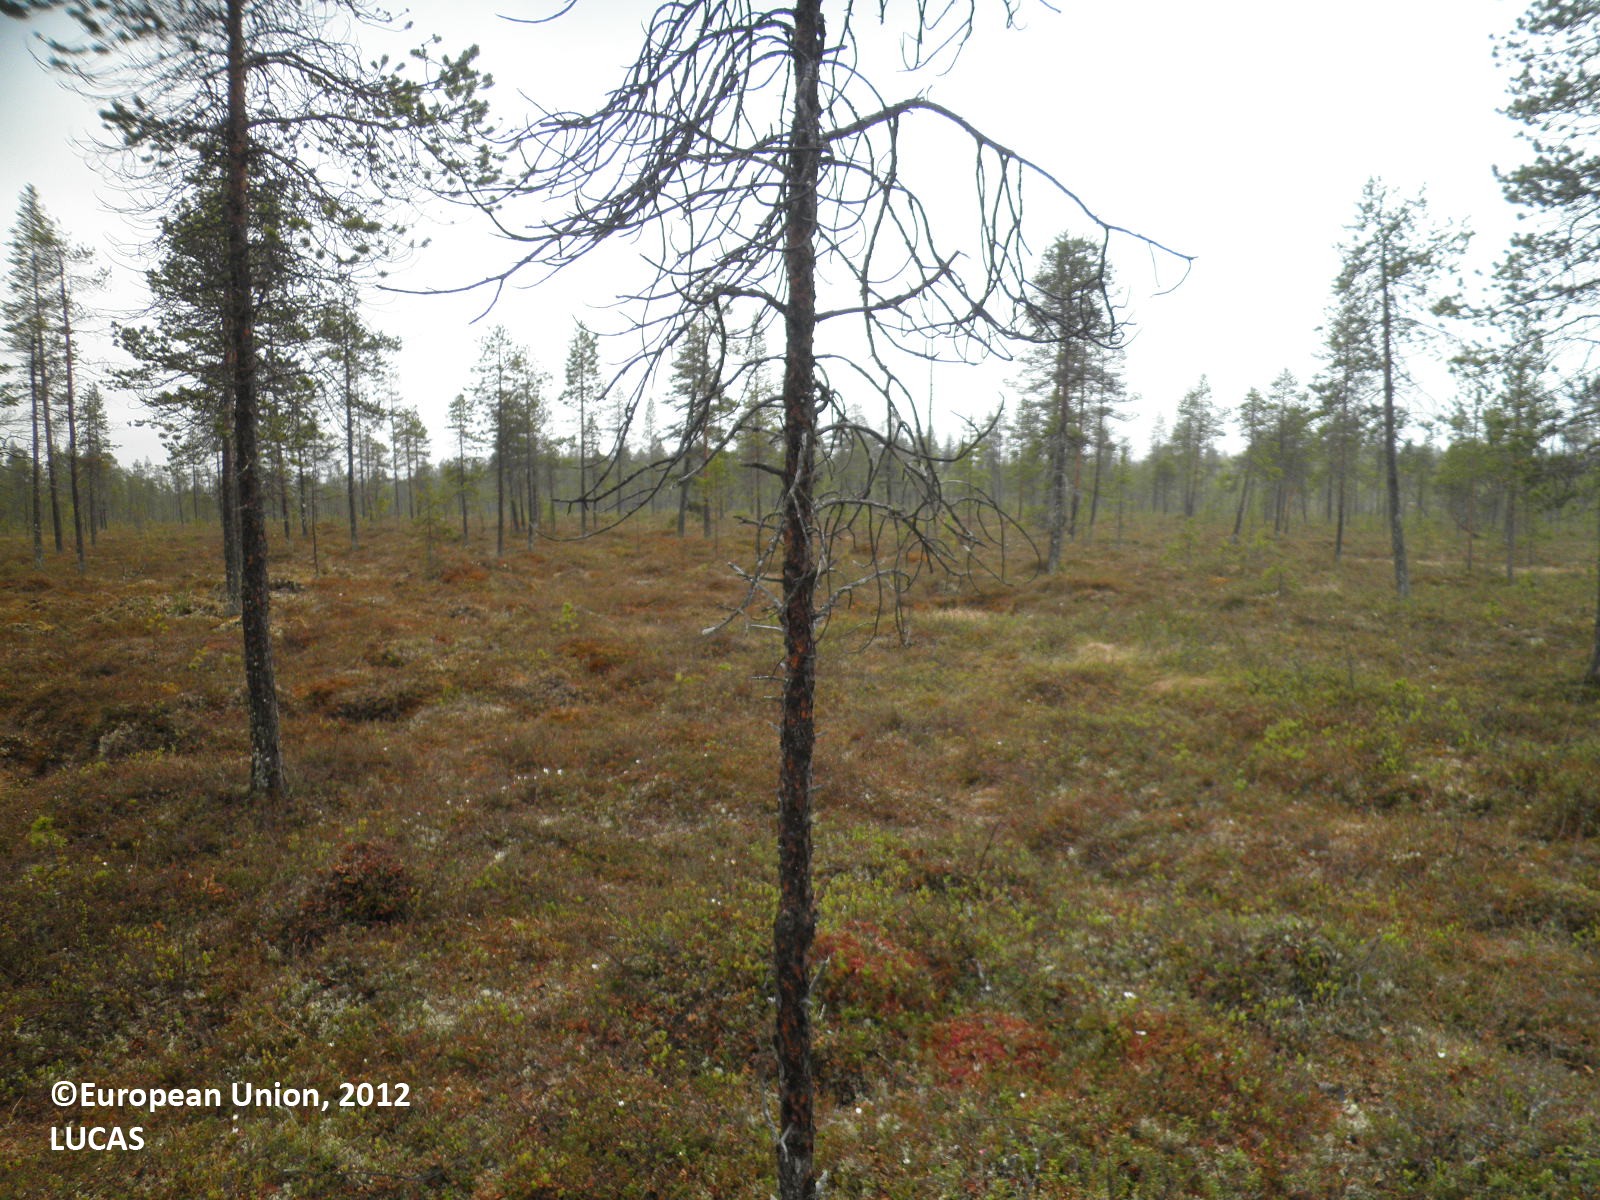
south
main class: Woodland
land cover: Pine dominated coniferous woodland
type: boreal forest
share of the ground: 25 - 50 %
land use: Forestry
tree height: > 5 m
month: June
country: FI
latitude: 68.9019
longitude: 26.5016
